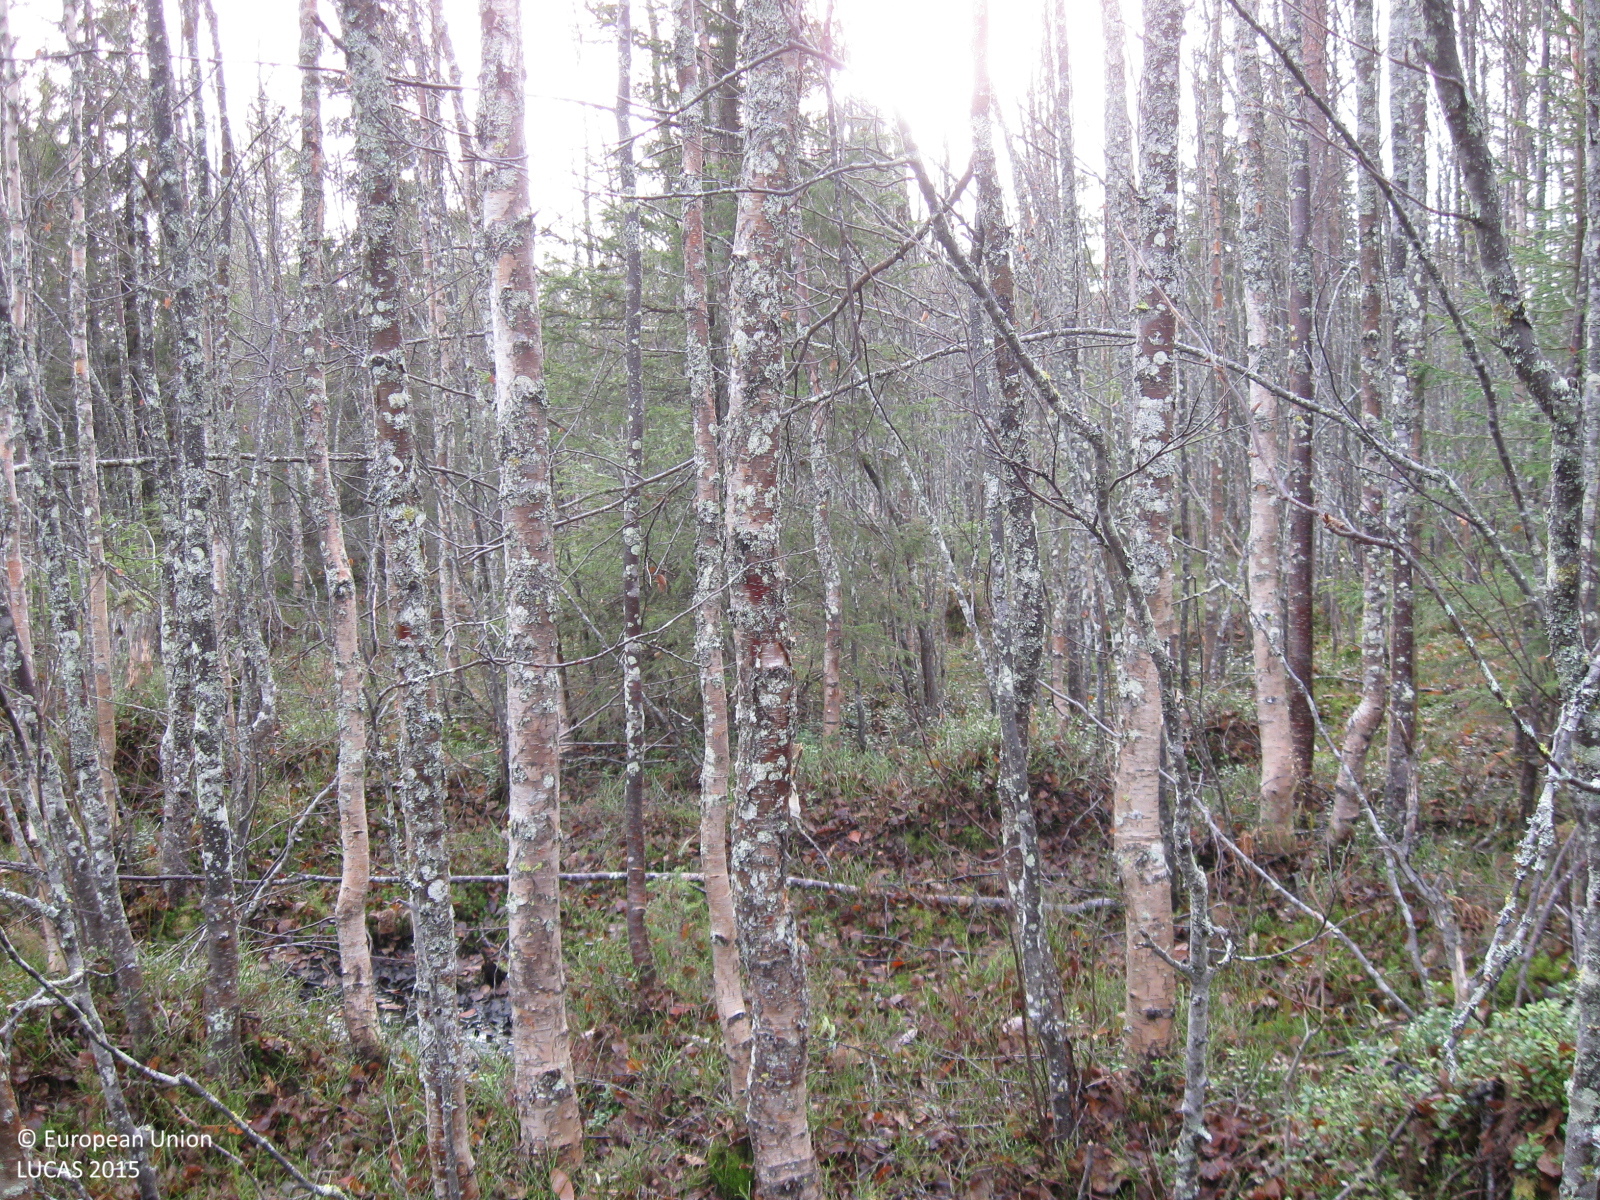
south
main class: Woodland
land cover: Broadleaved woodland
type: mire and swamp forests
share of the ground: > 75 %
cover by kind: broadleaved forest trees 70 %, coniferous forest trees 15 %, shrubs 5 %, herbaceous plants 5 %, lichens and mosses 5 %
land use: Forestry
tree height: > 5 m
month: October
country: SE
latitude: 66.5768
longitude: 21.7993
